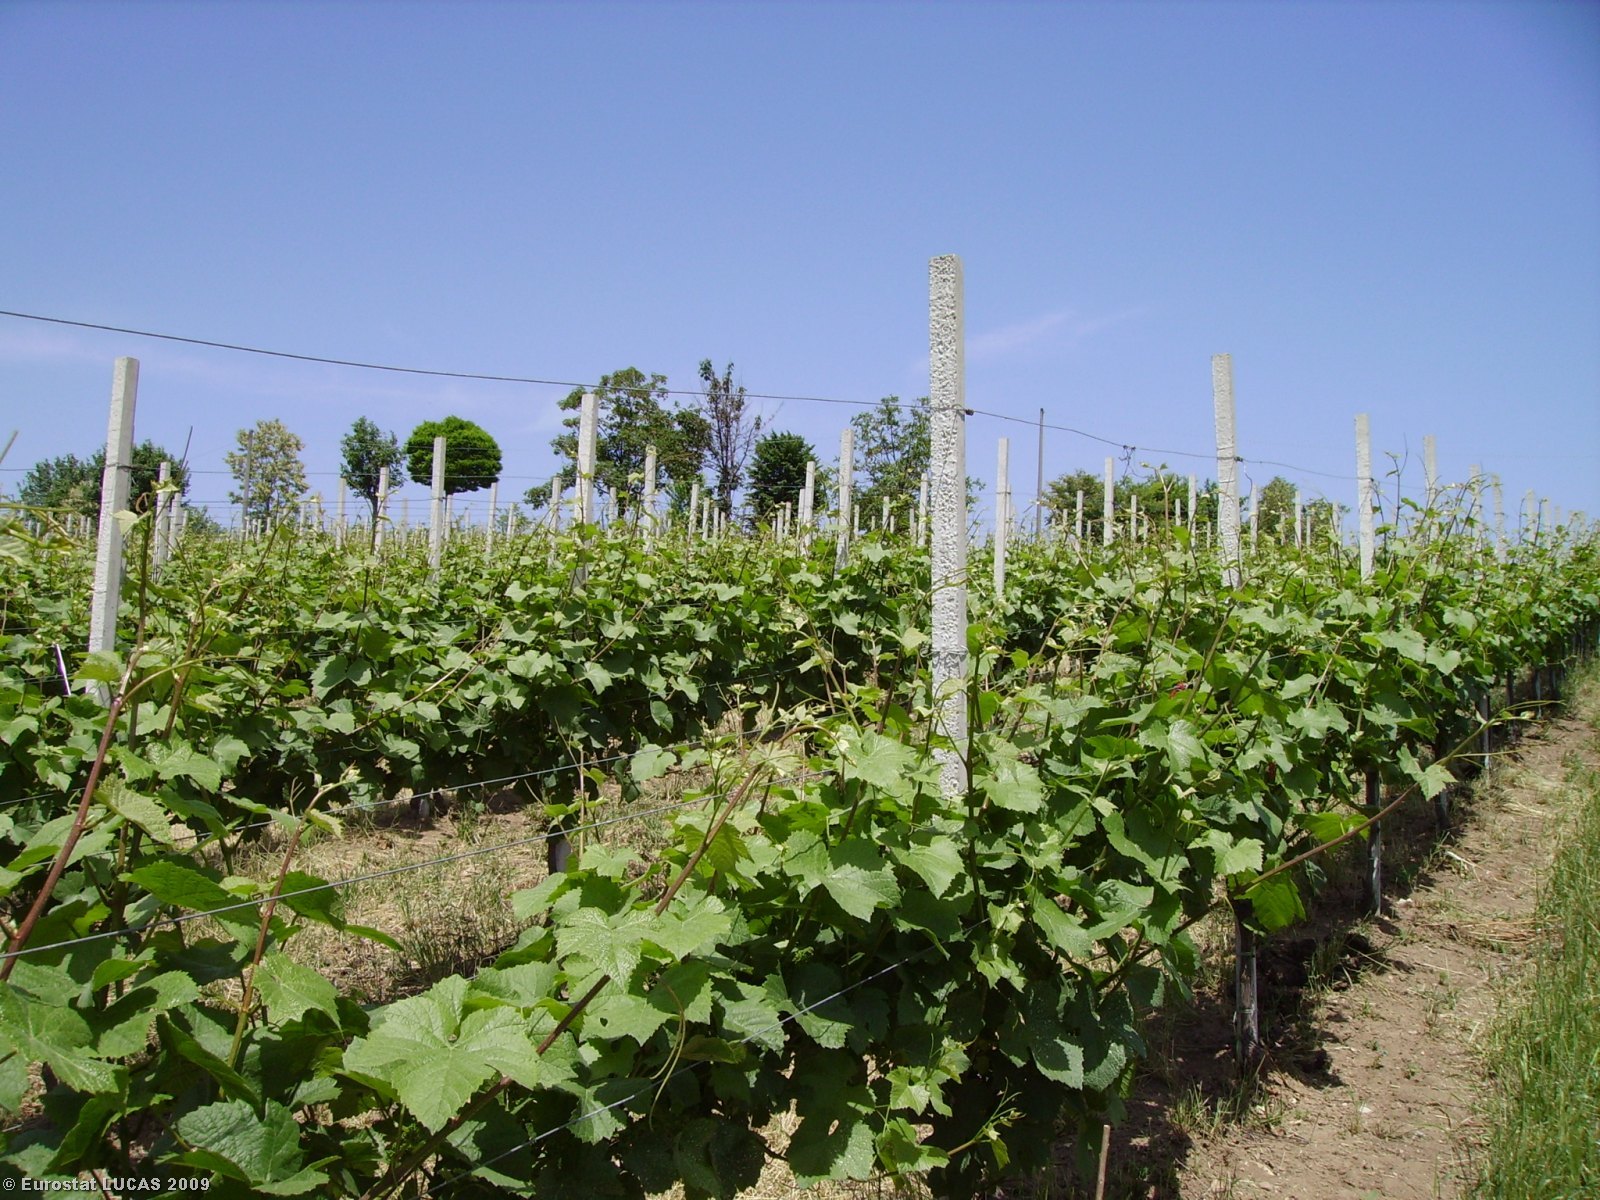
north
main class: Cropland
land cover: Vineyards
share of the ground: 50 - 75 %
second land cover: Grassland with sparse tree/shrub cover
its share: 50 - 75 %
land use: Agriculture (excluding fallow land and kitchen gardens)
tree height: < 5 m
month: May
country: IT
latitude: 44.9251
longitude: 9.2793
